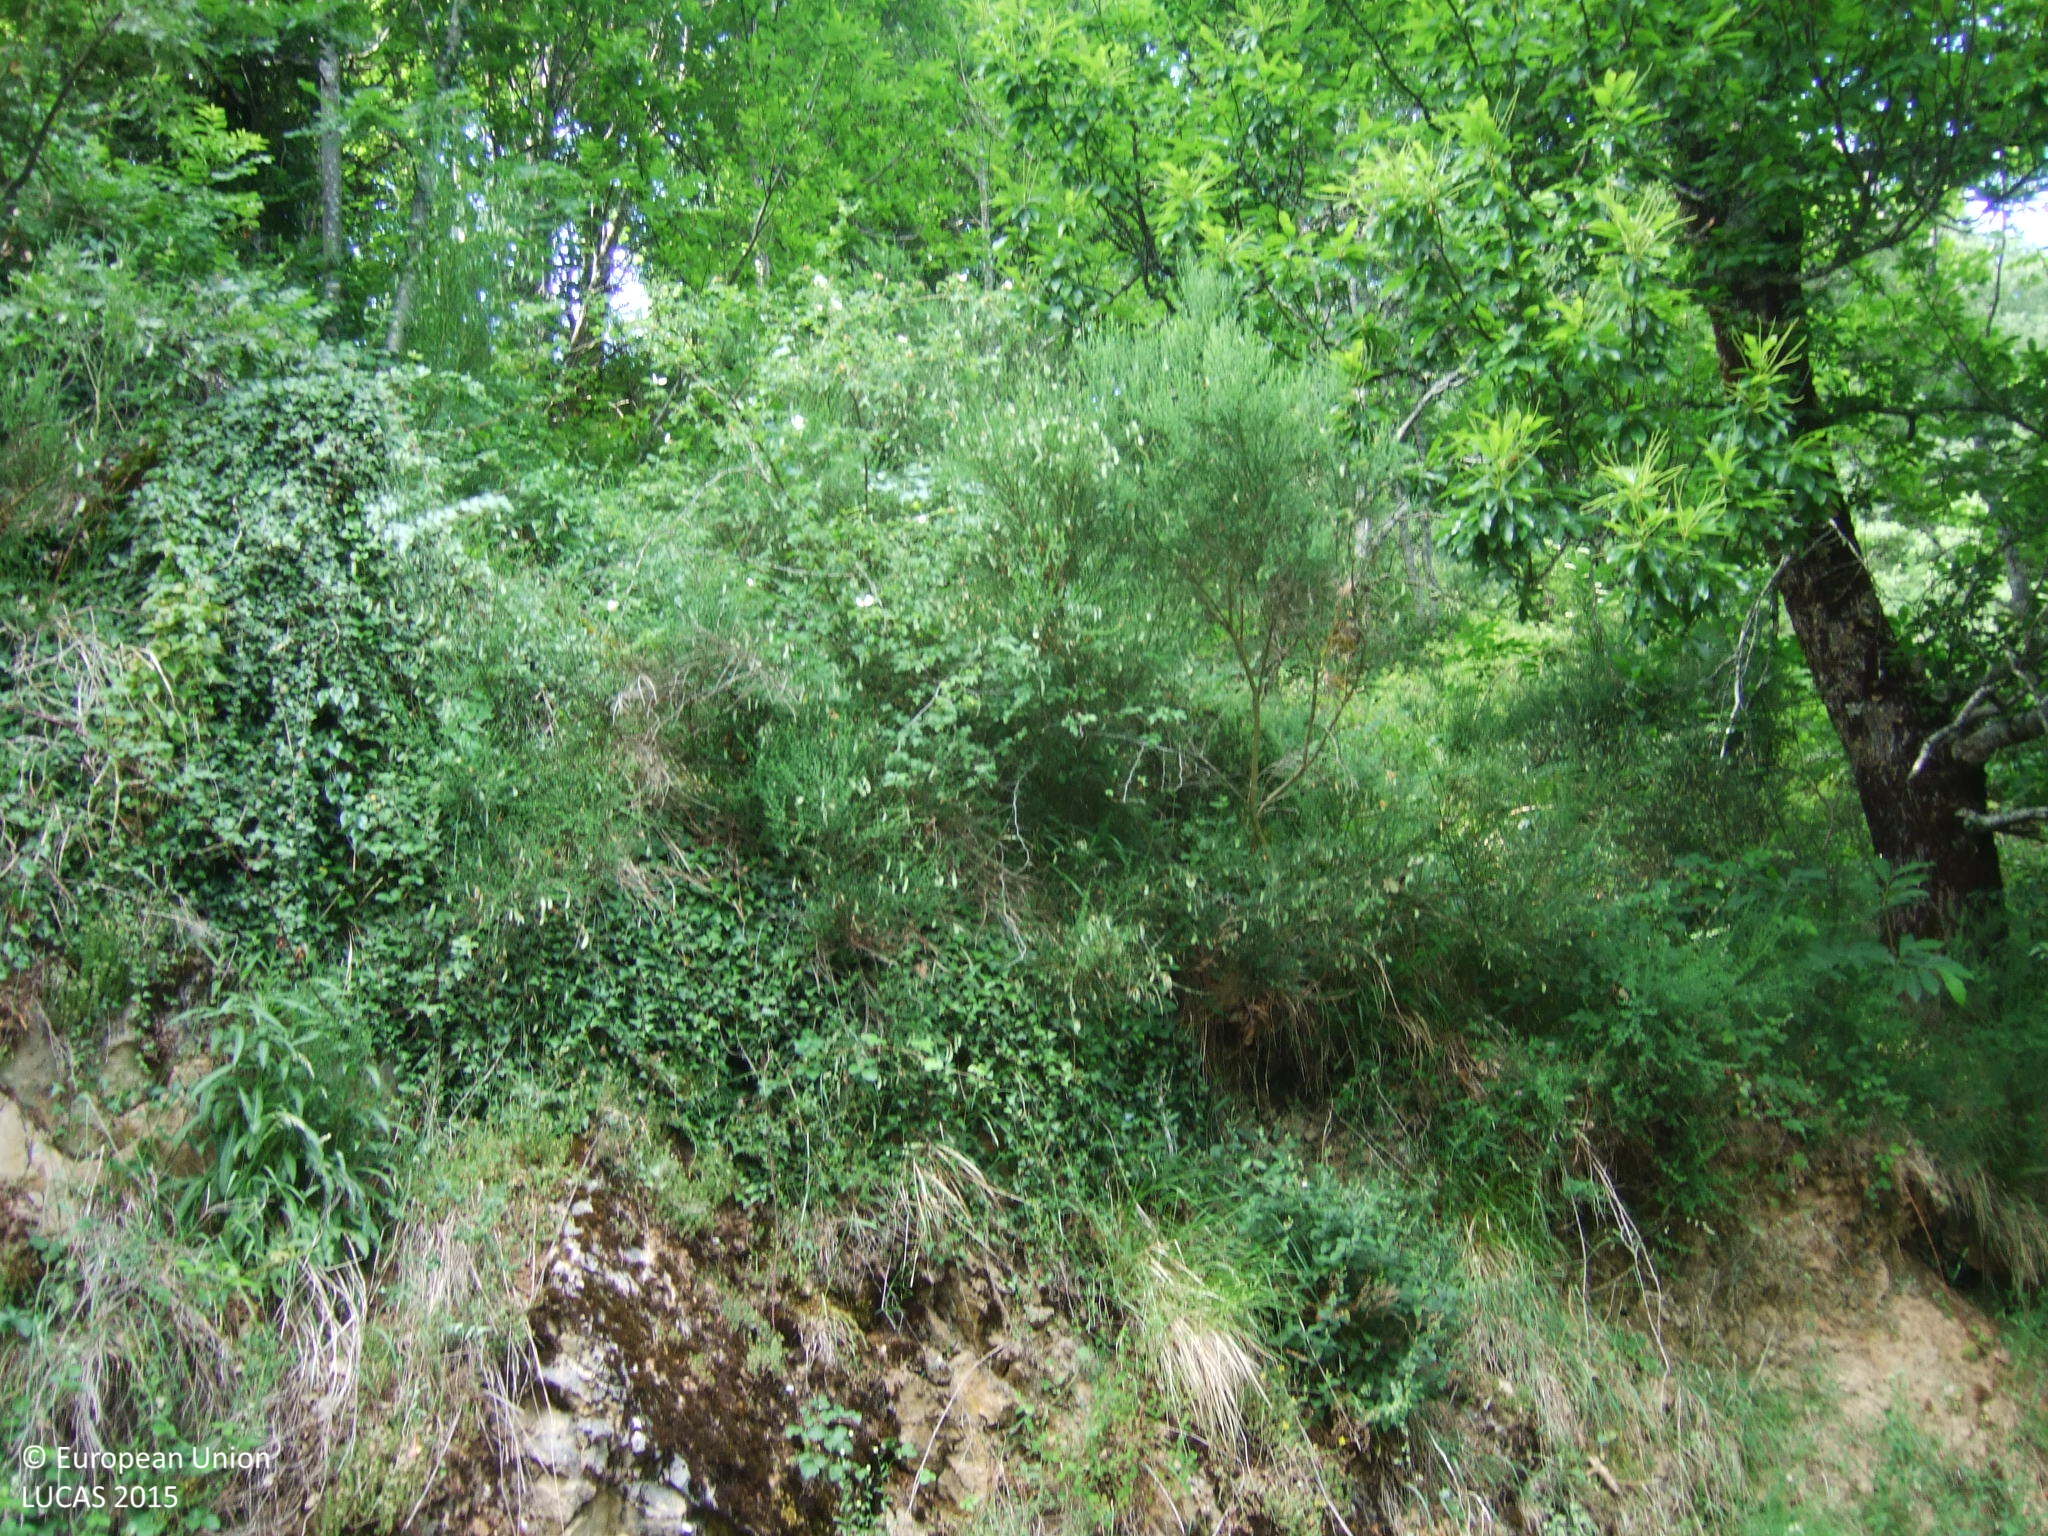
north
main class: Woodland
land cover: Broadleaved woodland
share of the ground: 50 - 75 %
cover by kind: broadleaved forest trees 65 %, shrubs 35 %
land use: Semi-natural and natural areas not in use
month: June
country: ES
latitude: 42.6505
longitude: -7.0507
